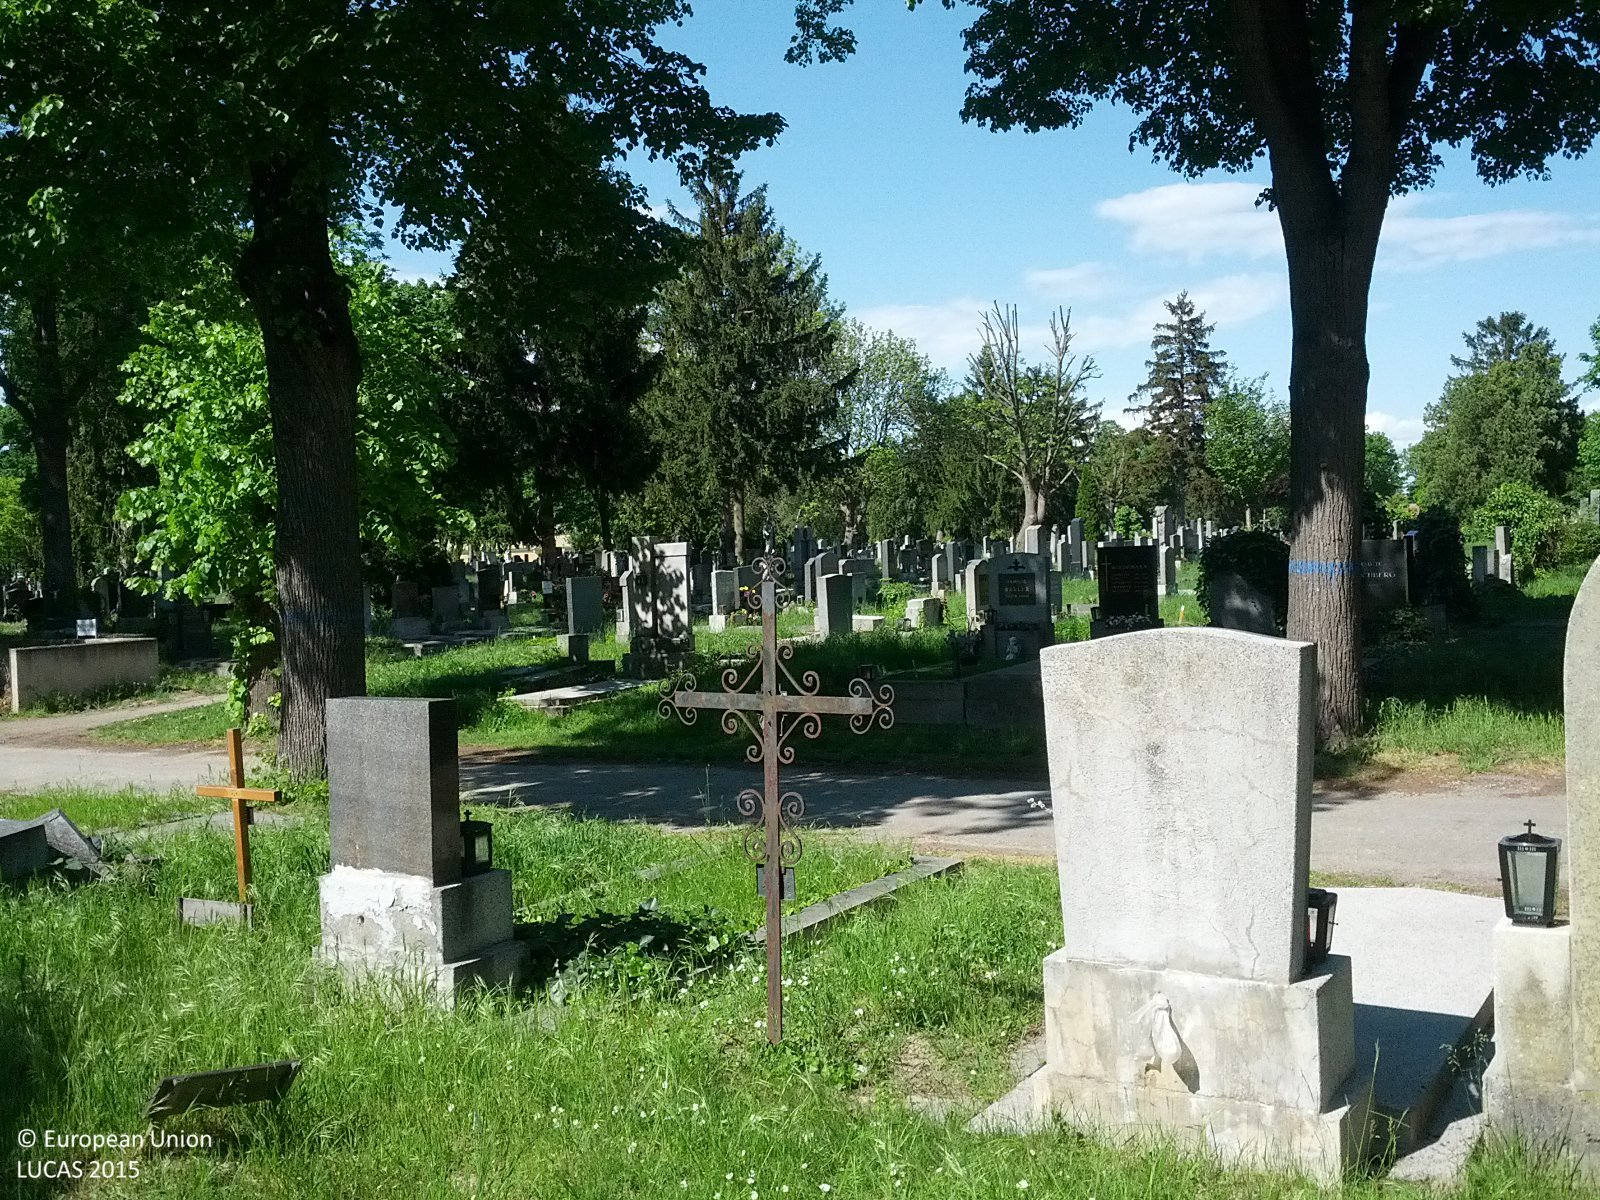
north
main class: Woodland
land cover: Broadleaved woodland
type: mesophytic deciduous forest
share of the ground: < 10 %
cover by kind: herbaceous plants 70 %, broadleaved forest trees 15 %, consolidated bare surface 15 %
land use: Community services
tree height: > 5 m
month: May
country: AT
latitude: 48.1434
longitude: 16.4428
